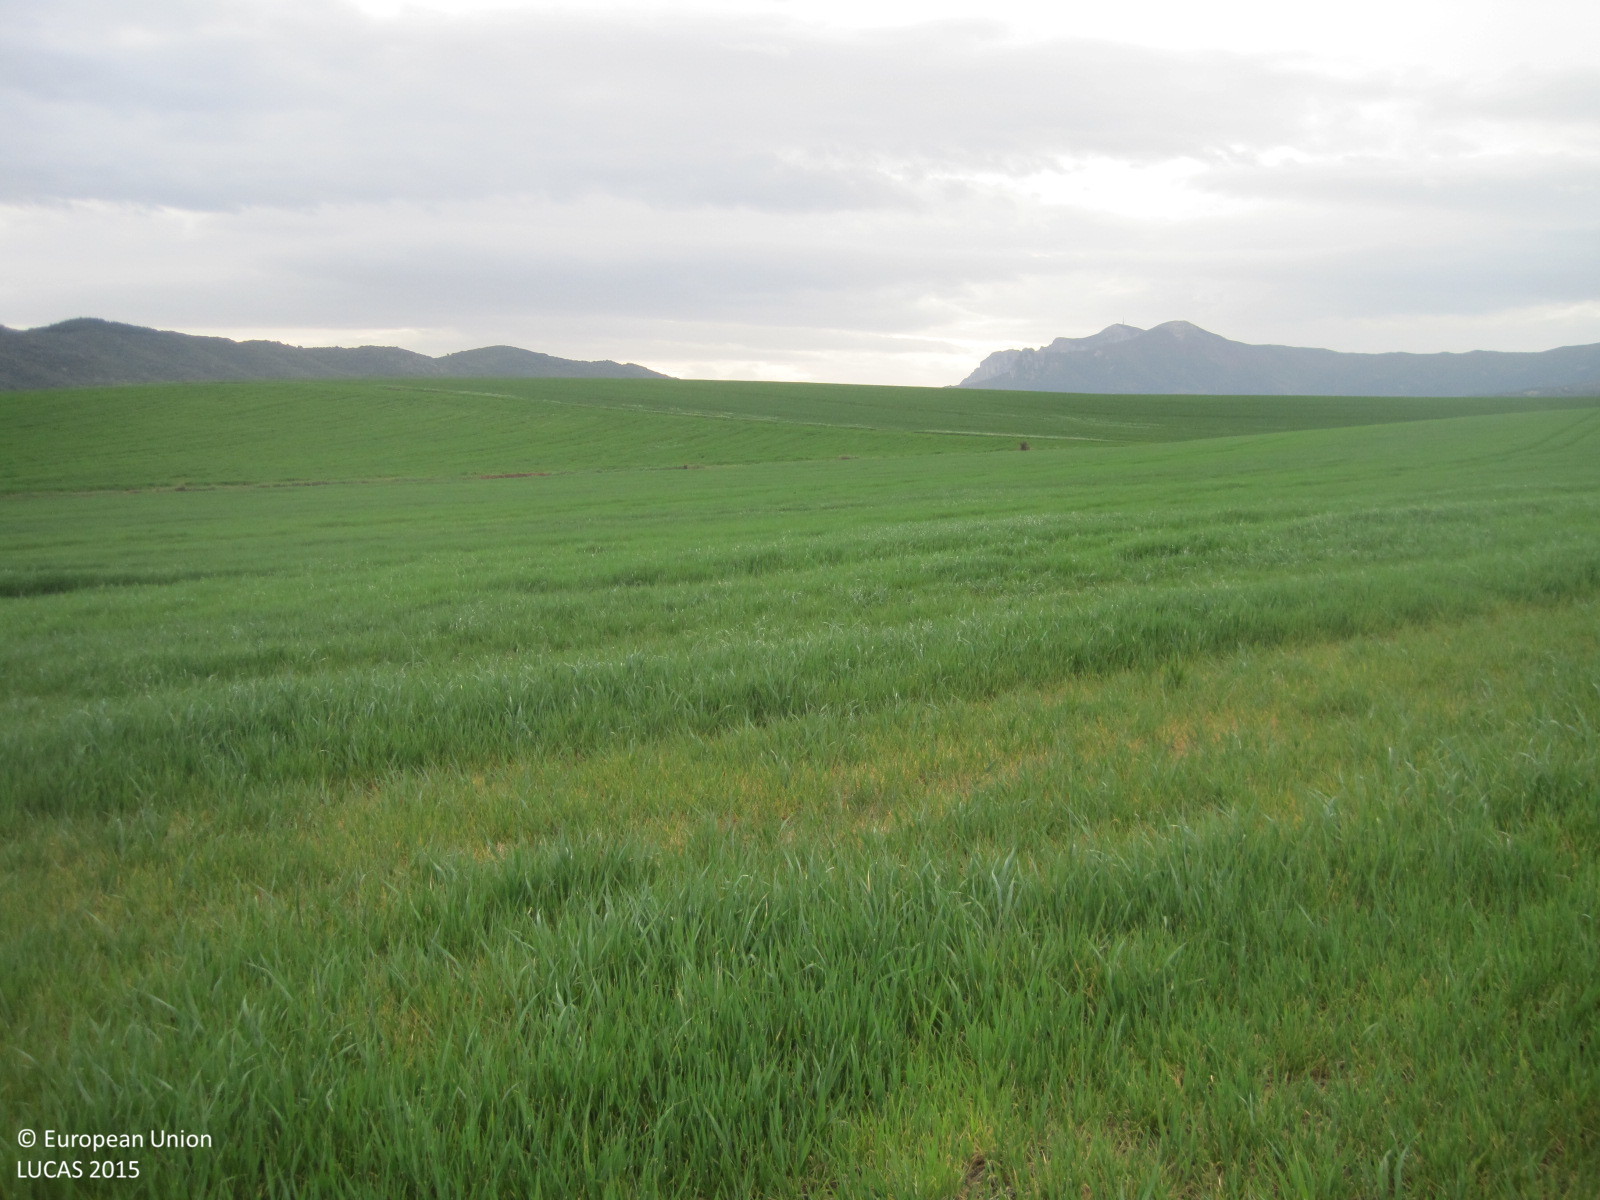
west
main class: Cropland
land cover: Barley
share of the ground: > 75 %
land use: Agriculture (excluding fallow land and kitchen gardens)
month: April
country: ES
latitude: 42.6221
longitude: -2.2238
